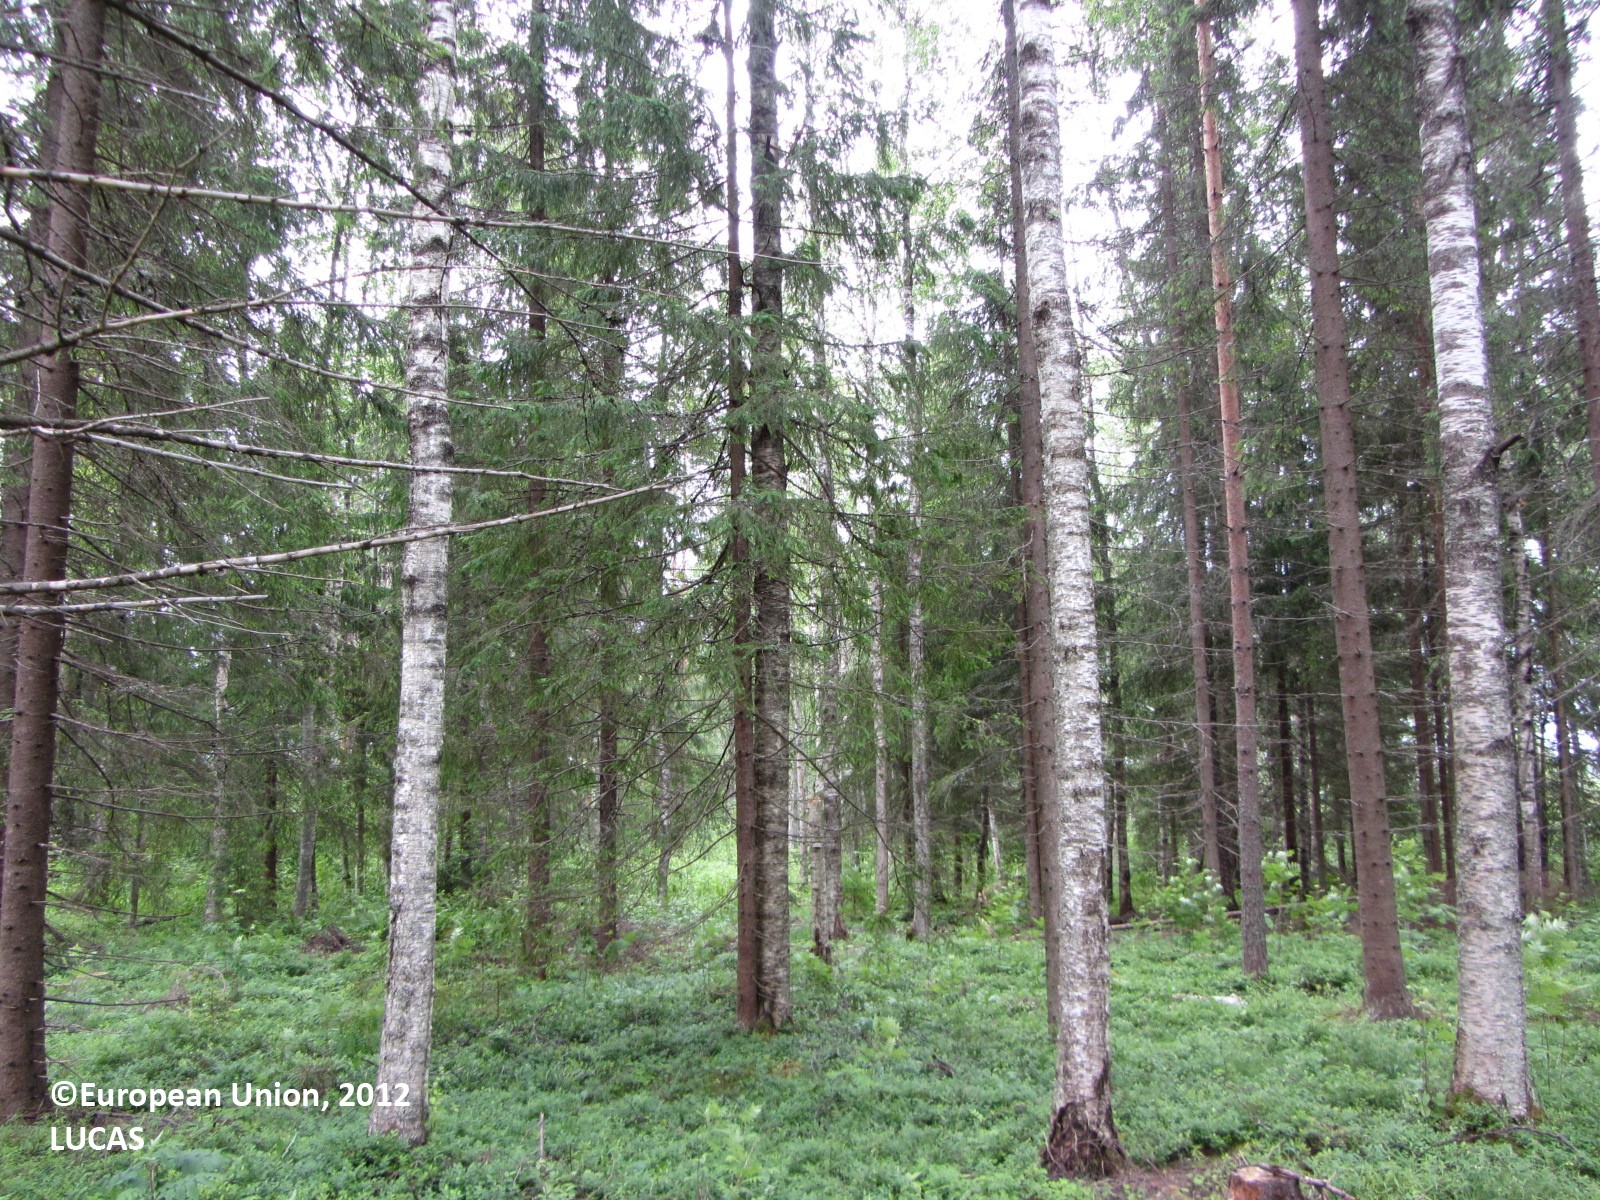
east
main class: Woodland
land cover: Spruce dominated mixed woodland
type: boreal forest
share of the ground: 50 - 75 %
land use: Forestry
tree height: > 5 m
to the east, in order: Spruce dominated mixed woodland; Spontaneously vegetated surfaces; Spruce dominated mixed woodland; Spontaneously vegetated surfaces; Electric lines; Pine dominated mixed woodland; Spontaneously vegetated surfaces; Grassland with sparse tree/shrub cover; Artificial constructions in urban areas; Dry stone walls; Grass margins; Tracks; Broadleaved woodland; Ditches and canals; Grass margins; Tracks; Other leguminous and mixtures for fodder; Spontaneously vegetated surfaces; Artificial constructions in urban areas; Other mixed woodland
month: June
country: FI
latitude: 62.5940
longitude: 25.5150
